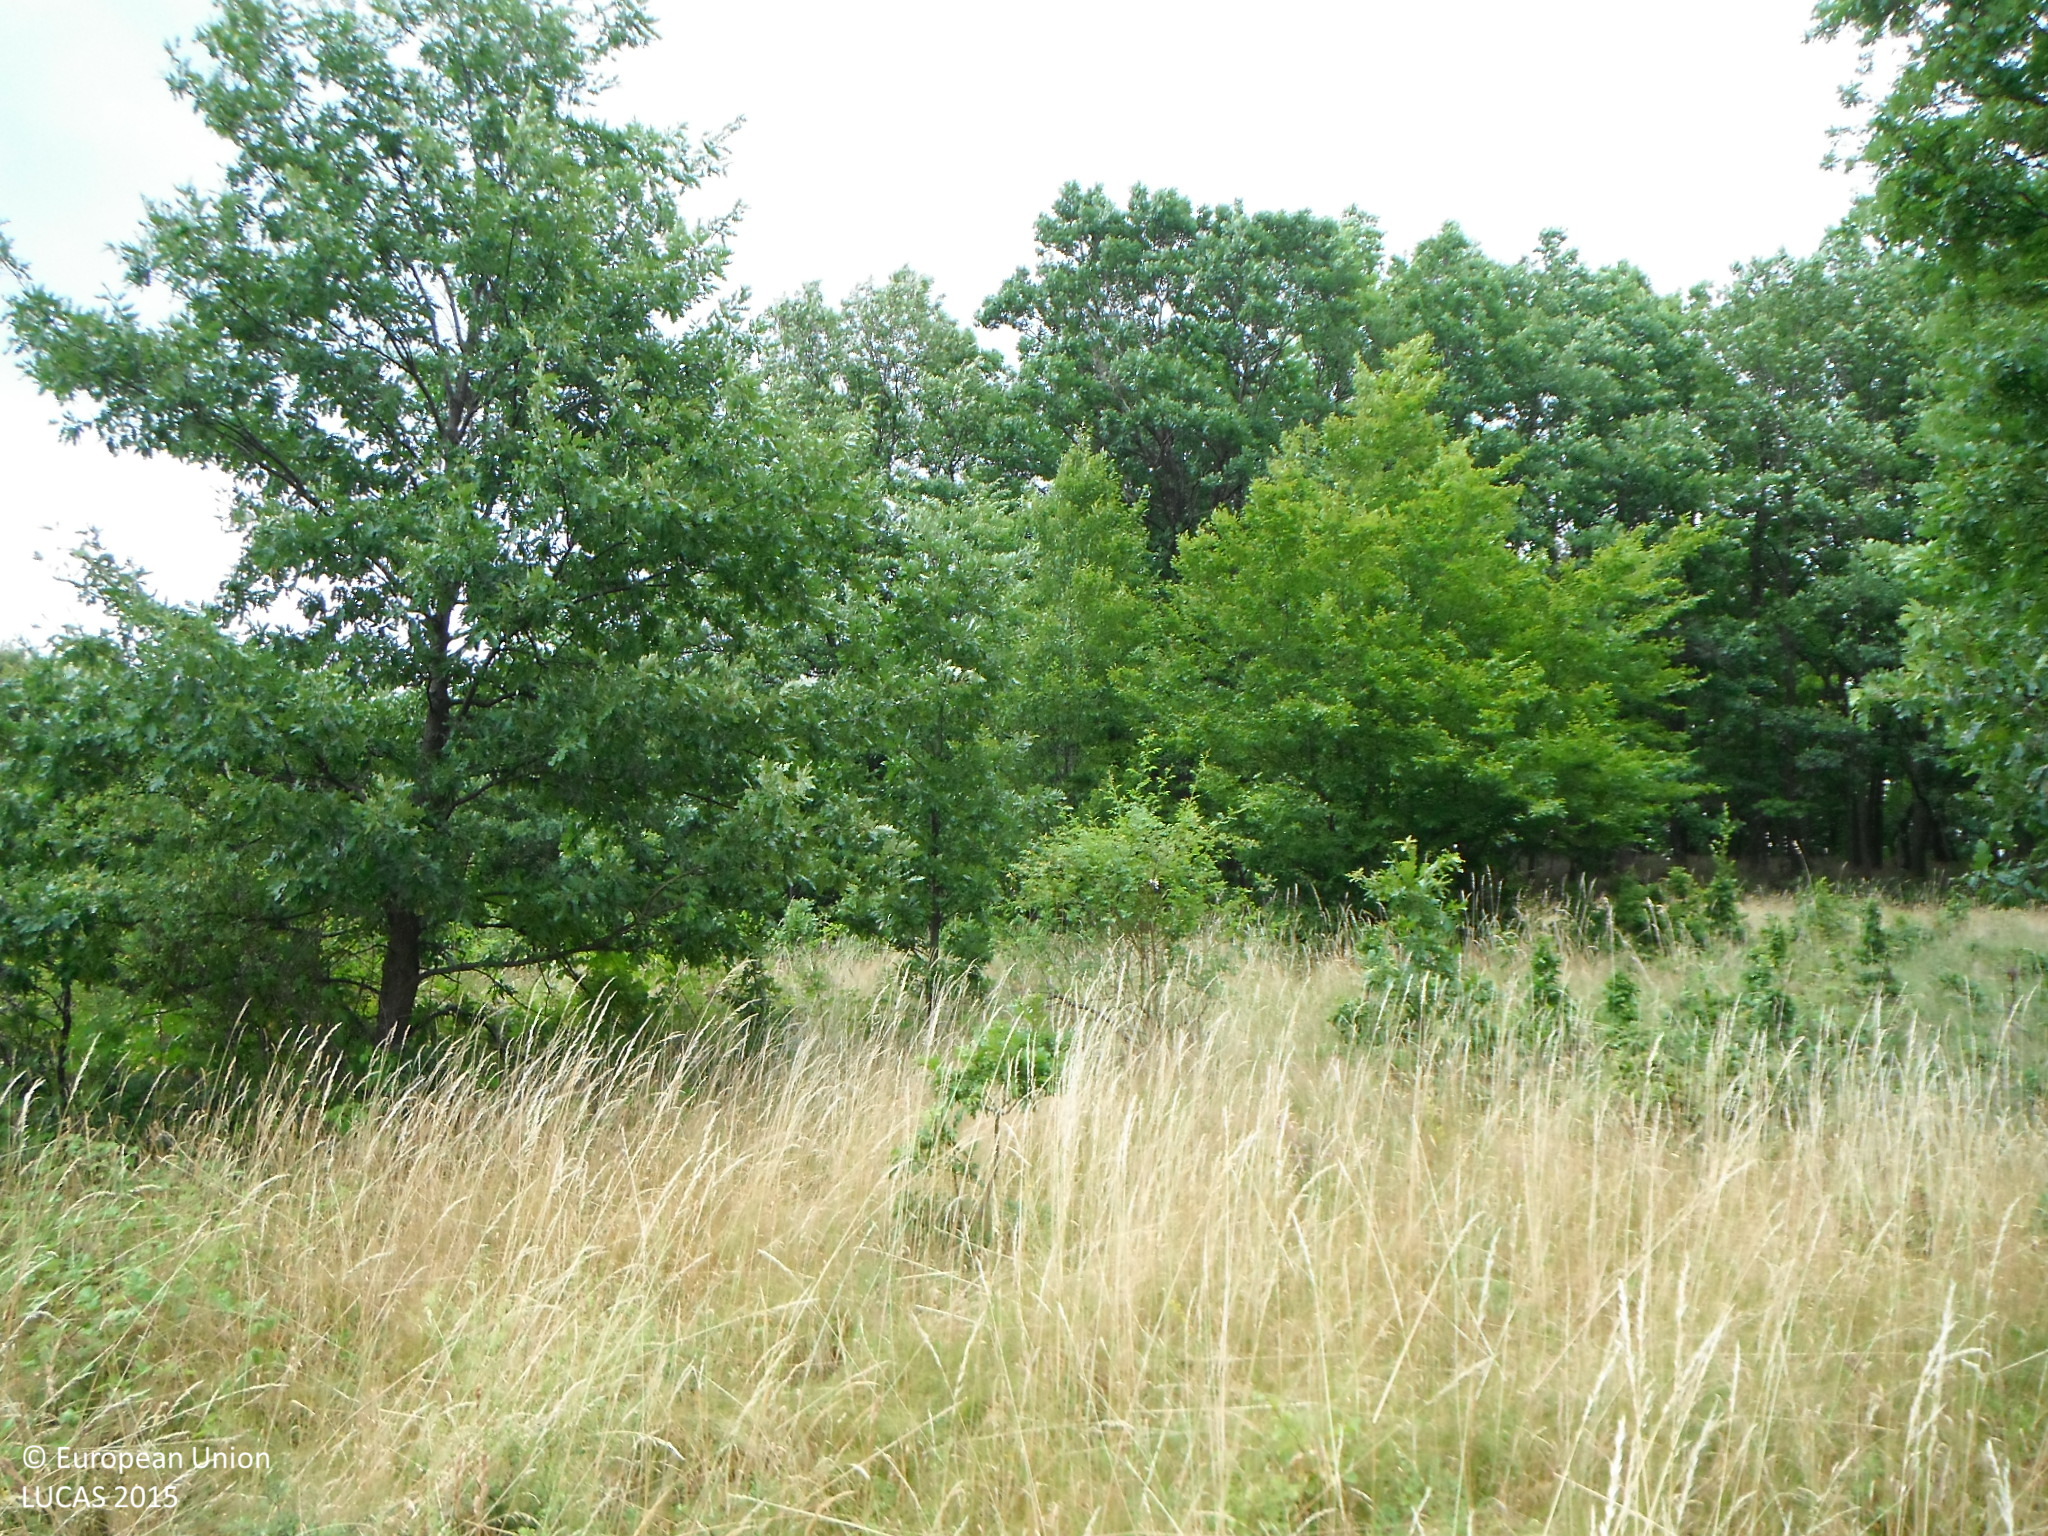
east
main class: Shrubland
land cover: Shrubland with sparse tree cover
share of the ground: > 75 %
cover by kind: shrubs 80 %, herbaceous plants 15 %, broadleaved forest trees 5 %
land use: Semi-natural and natural areas not in use
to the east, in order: Shrubland with sparse tree cover; Broadleaved woodland; Tracks; Broadleaved woodland
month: July
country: SK
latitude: 48.3799
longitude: 18.9990
